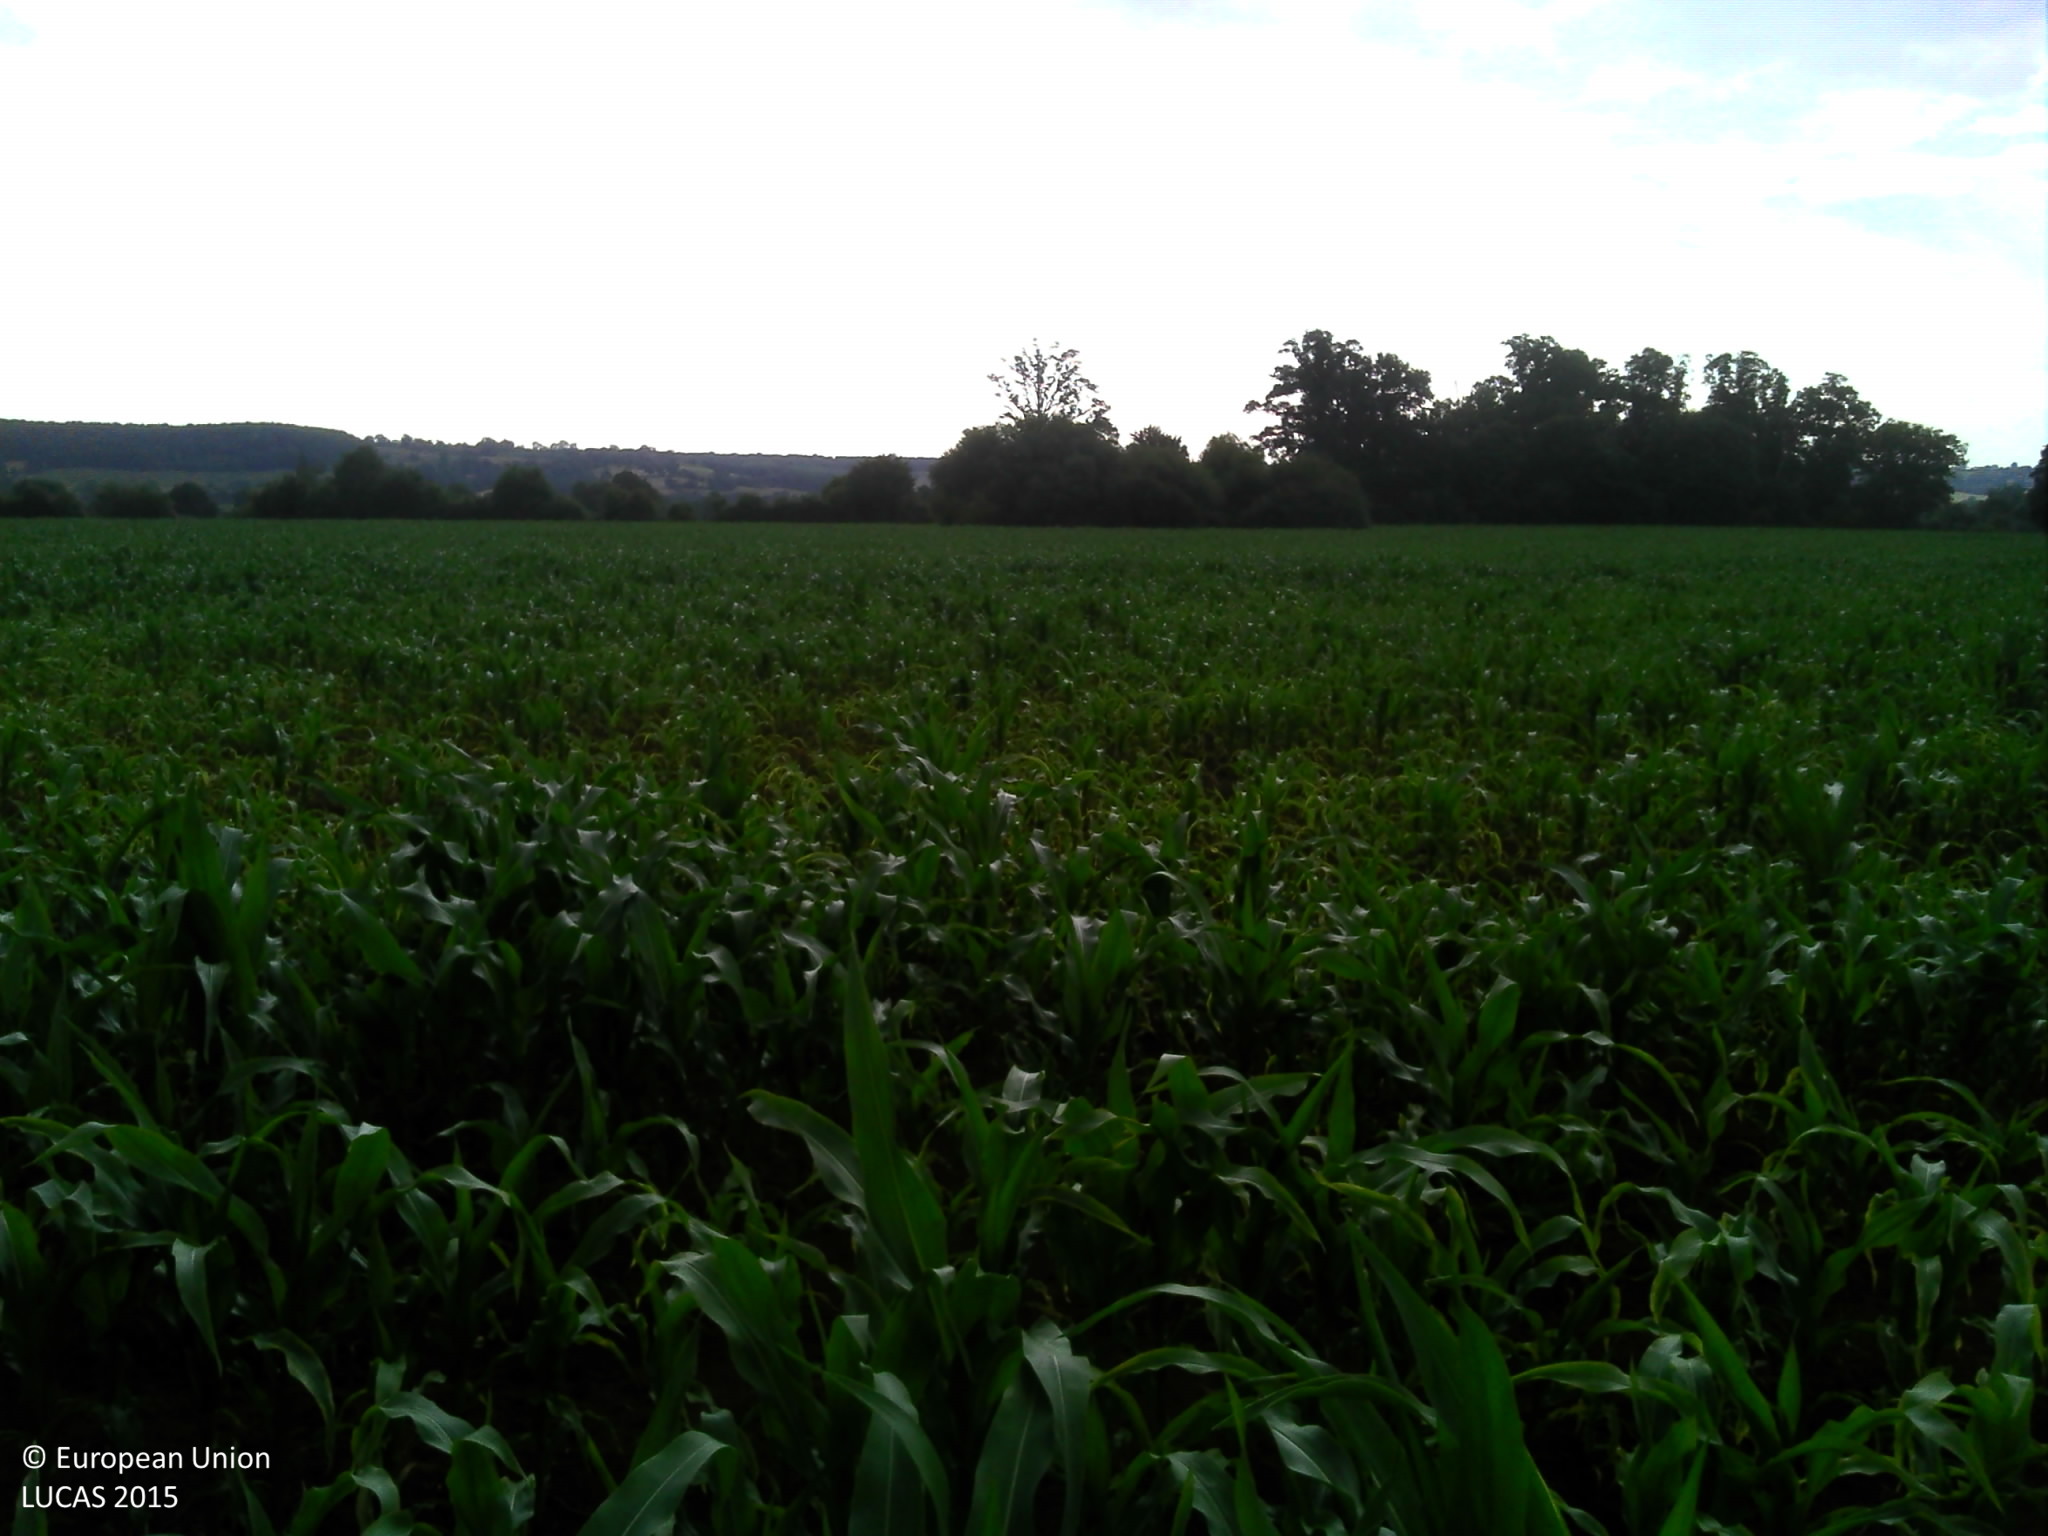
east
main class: Cropland
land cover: Maize
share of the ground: 25 - 50 %
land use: Agriculture (excluding fallow land and kitchen gardens)
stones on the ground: < 10 %
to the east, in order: Maize; Broadleaved woodland; Fences; Grassland without tree/shrub cover
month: July
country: FR
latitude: 48.9297
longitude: 0.0191
